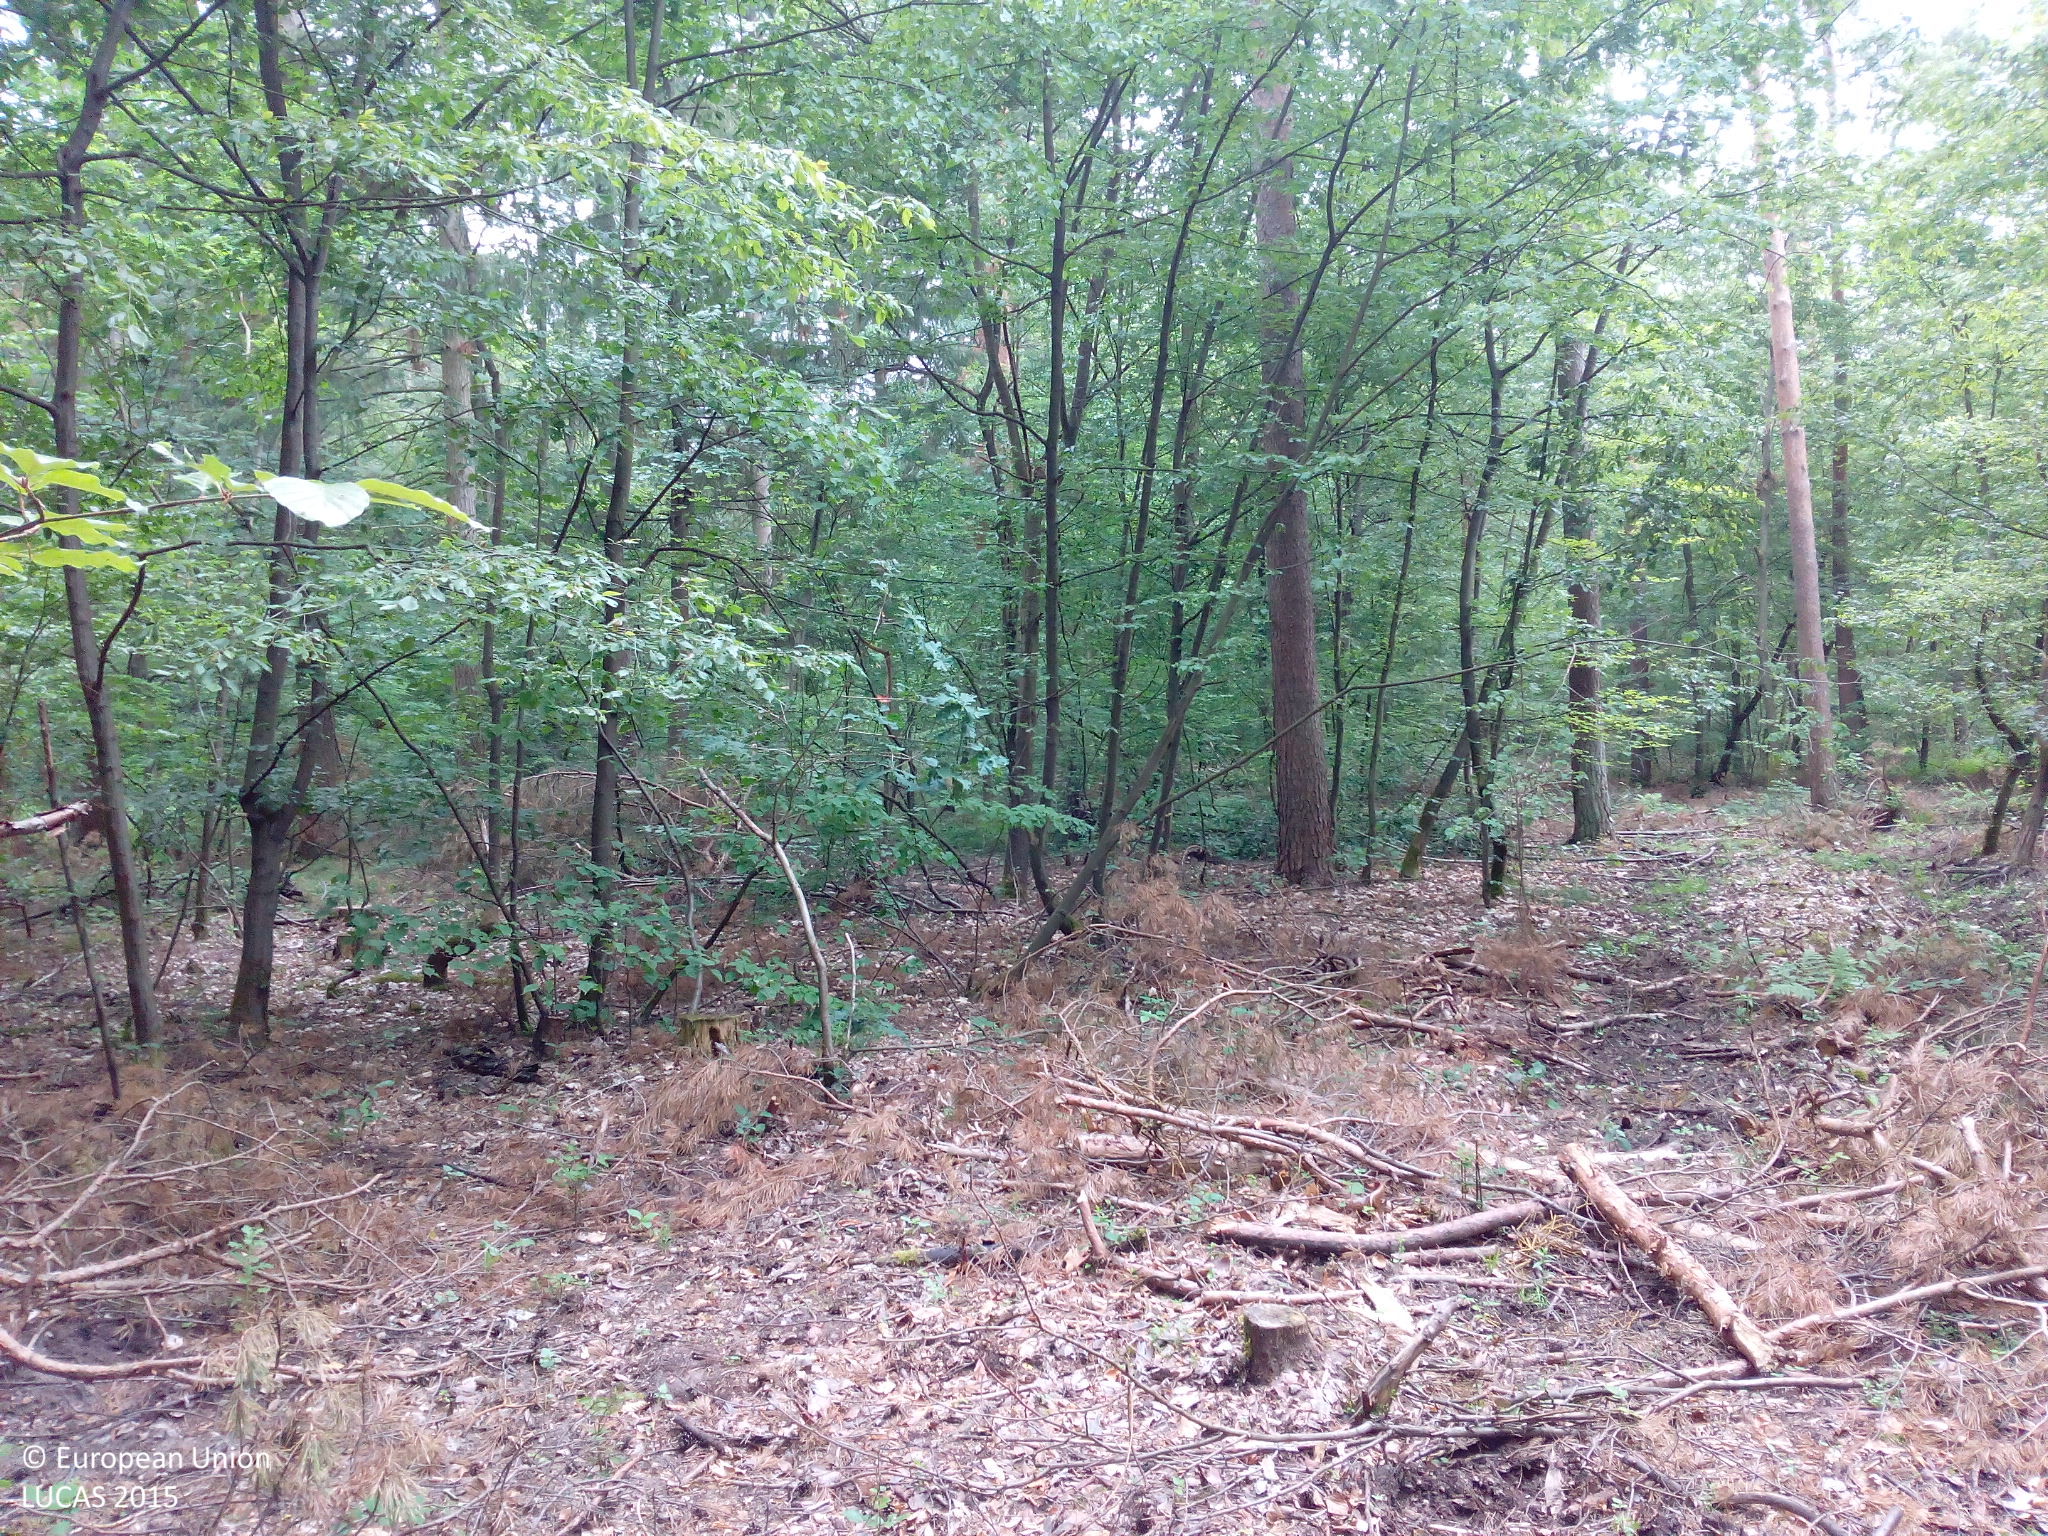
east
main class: Woodland
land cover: Broadleaved woodland
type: beech forest
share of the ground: > 75 %
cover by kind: broadleaved forest trees 70 %, coniferous forest trees 15 %, unconsolidated bare surface 10 %, herbaceous plants 5 %
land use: Forestry
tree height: > 5 m
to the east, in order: Broadleaved woodland; Grass margins; Tracks; Grass margins; Pine dominated mixed woodland; Broadleaved woodland; Grass margins; Tracks; Grass margins; Broadleaved woodland
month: June
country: DE
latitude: 49.2574
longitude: 8.5303
